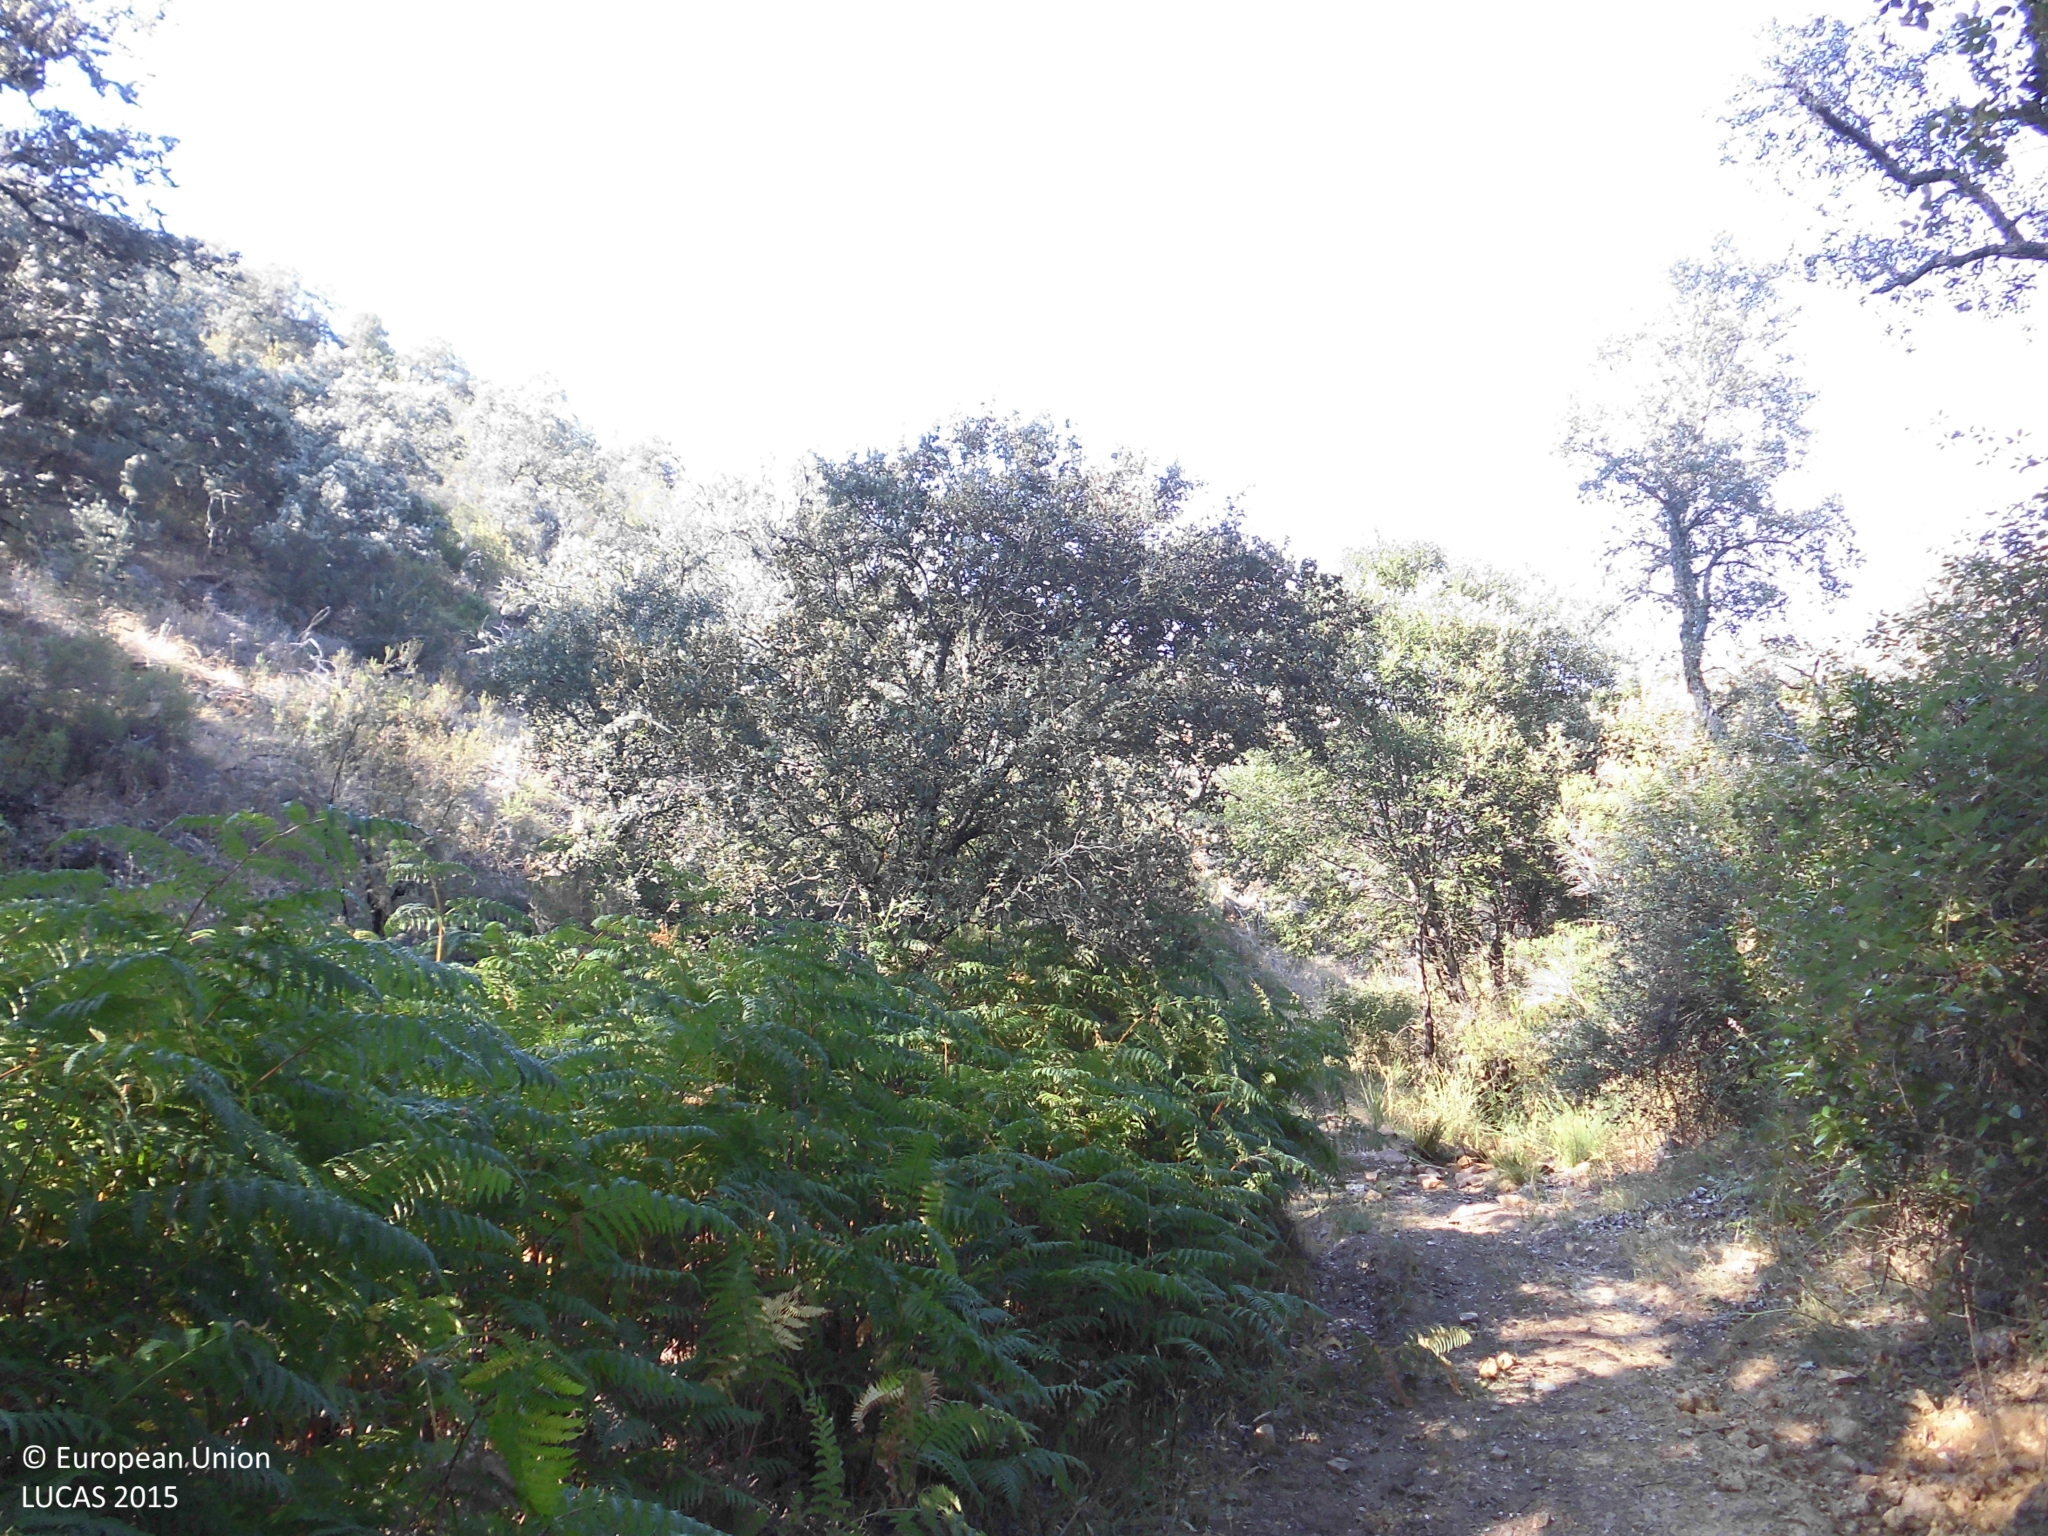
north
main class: Shrubland
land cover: Shrubland with sparse tree cover
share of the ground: > 75 %
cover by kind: shrubs 90 %, broadleaved forest trees 5 %, herbaceous plants 5 %
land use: Semi-natural and natural areas not in use
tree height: > 5 m
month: June
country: ES
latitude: 39.6534
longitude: -5.3780
